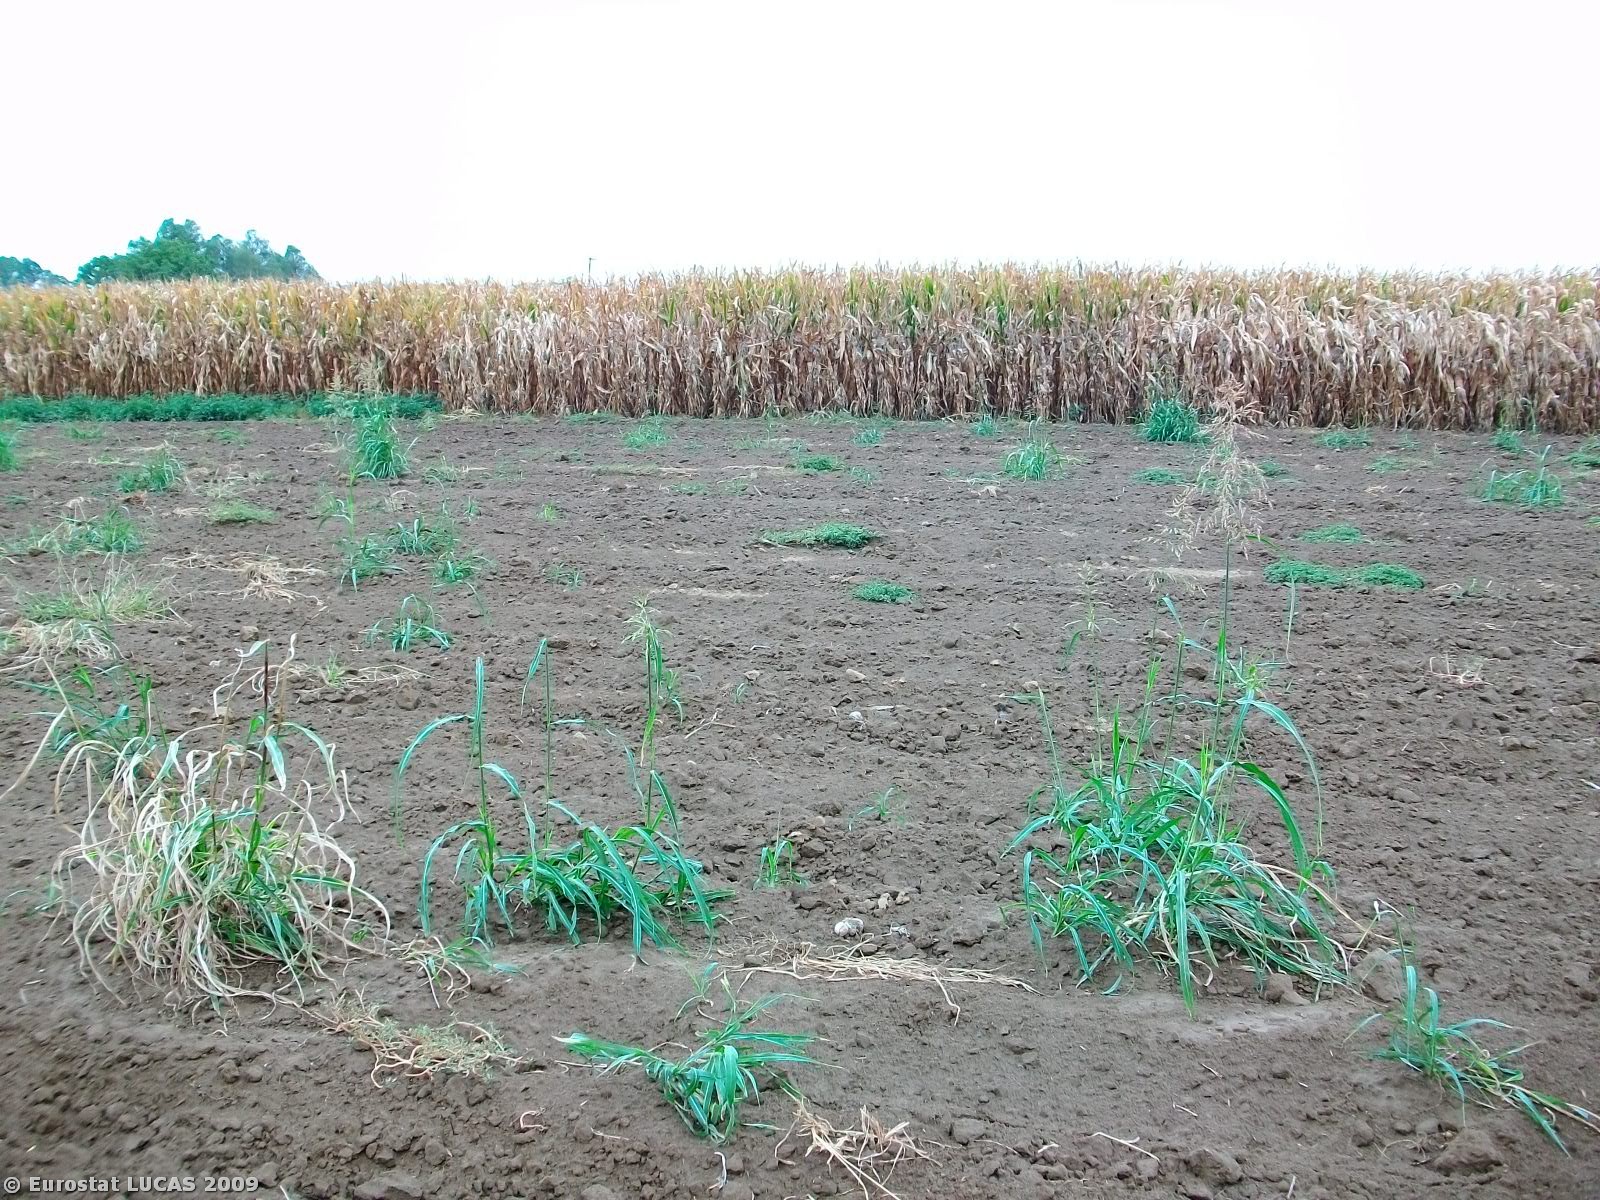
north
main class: Cropland
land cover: Other fresh vegetables
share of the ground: < 10 %
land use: Agriculture (excluding fallow land and kitchen gardens)
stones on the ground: < 10 %
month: September
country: GR
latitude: 41.5977
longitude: 26.5294
